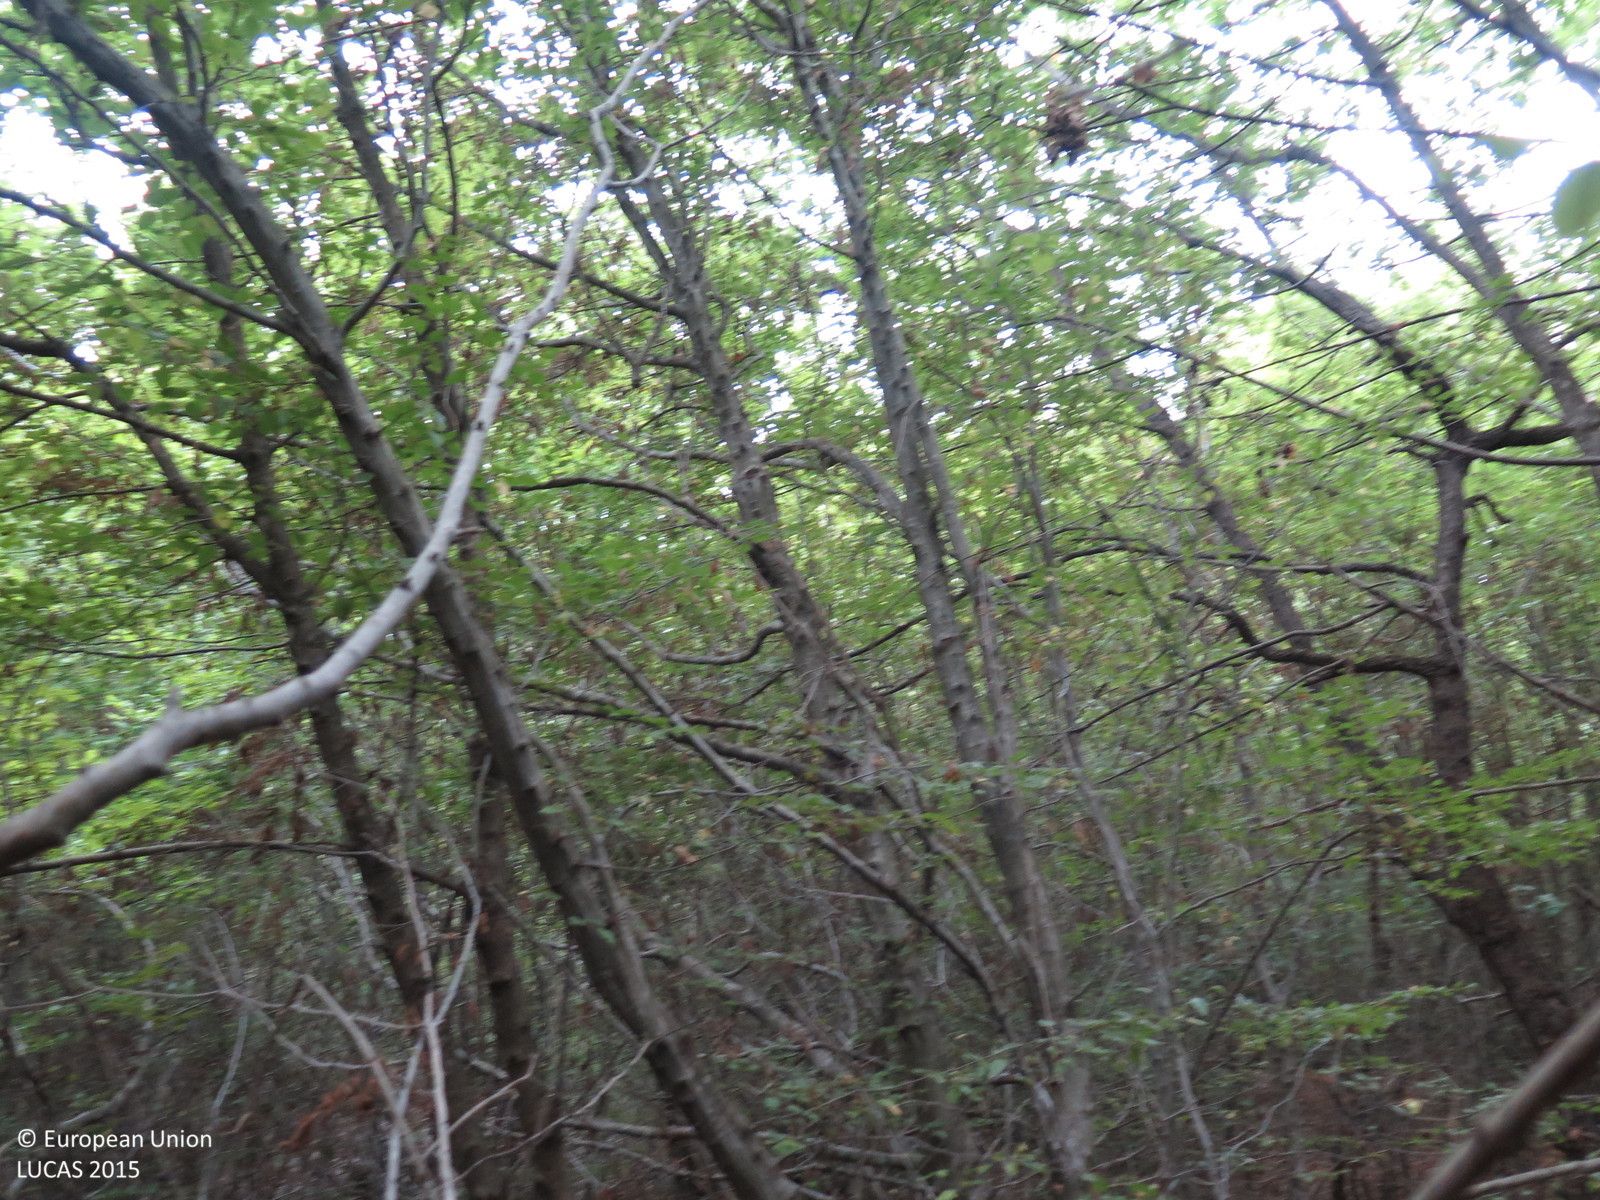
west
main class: Woodland
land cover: Broadleaved woodland
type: beech forest
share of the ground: > 75 %
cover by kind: broadleaved forest trees 100 %
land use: Forestry
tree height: > 5 m
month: August
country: HR
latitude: 45.0970
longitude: 14.6072
